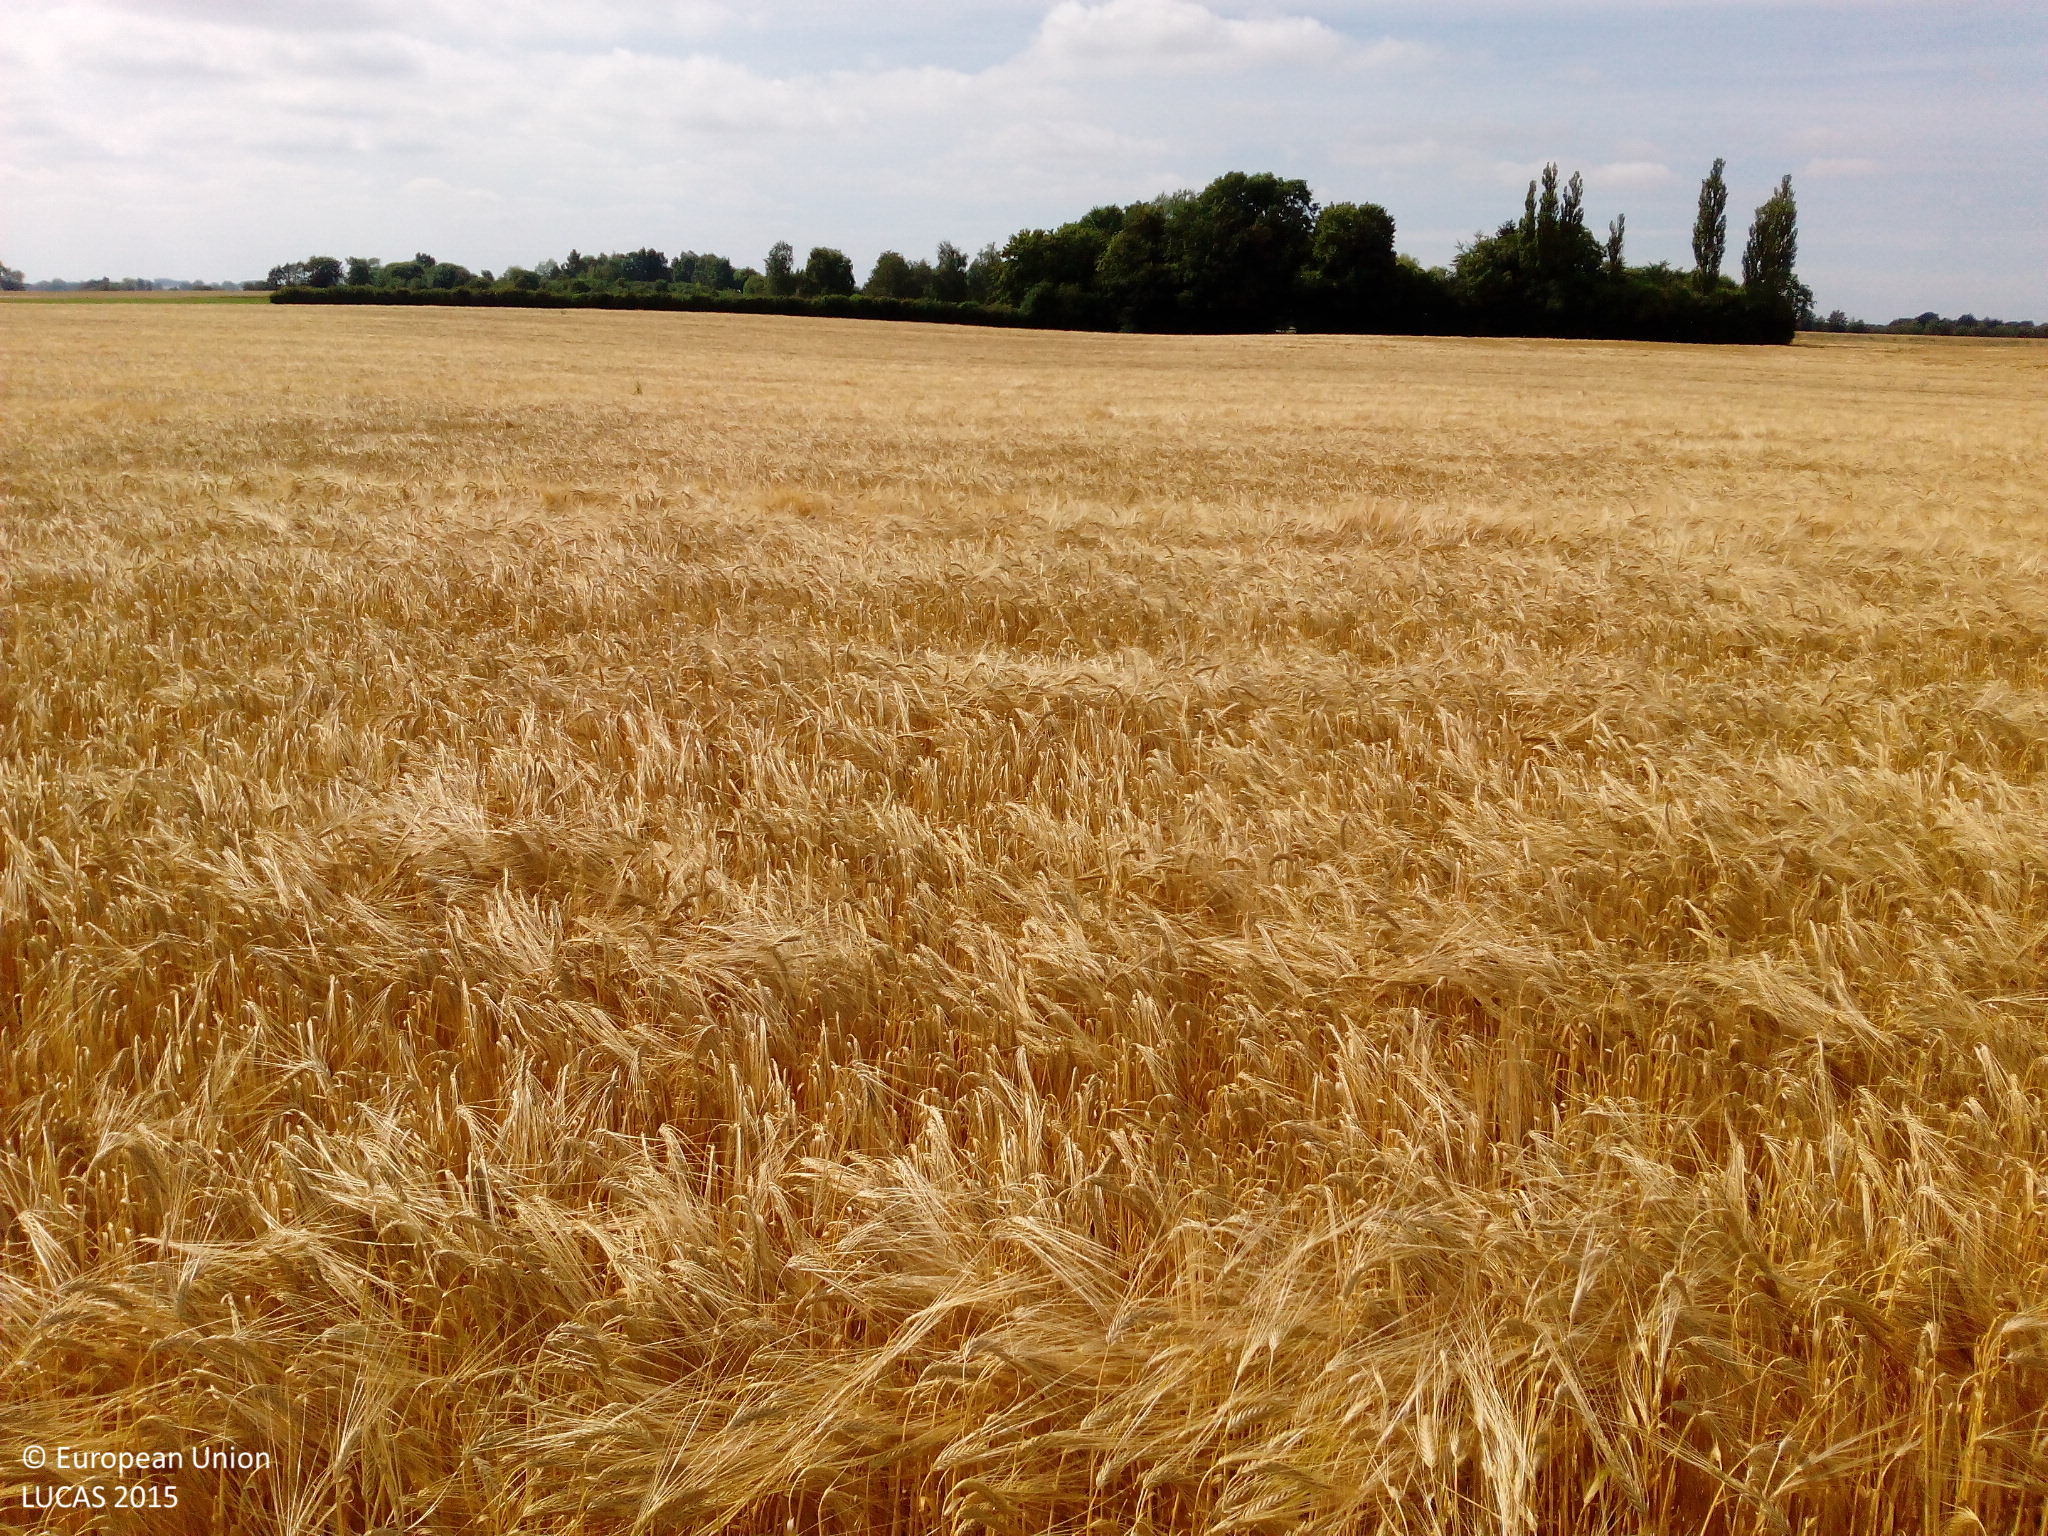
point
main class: Cropland
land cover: Barley
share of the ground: > 75 %
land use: Agriculture (excluding fallow land and kitchen gardens)
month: August
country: DK
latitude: 55.5760
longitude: 12.1712
